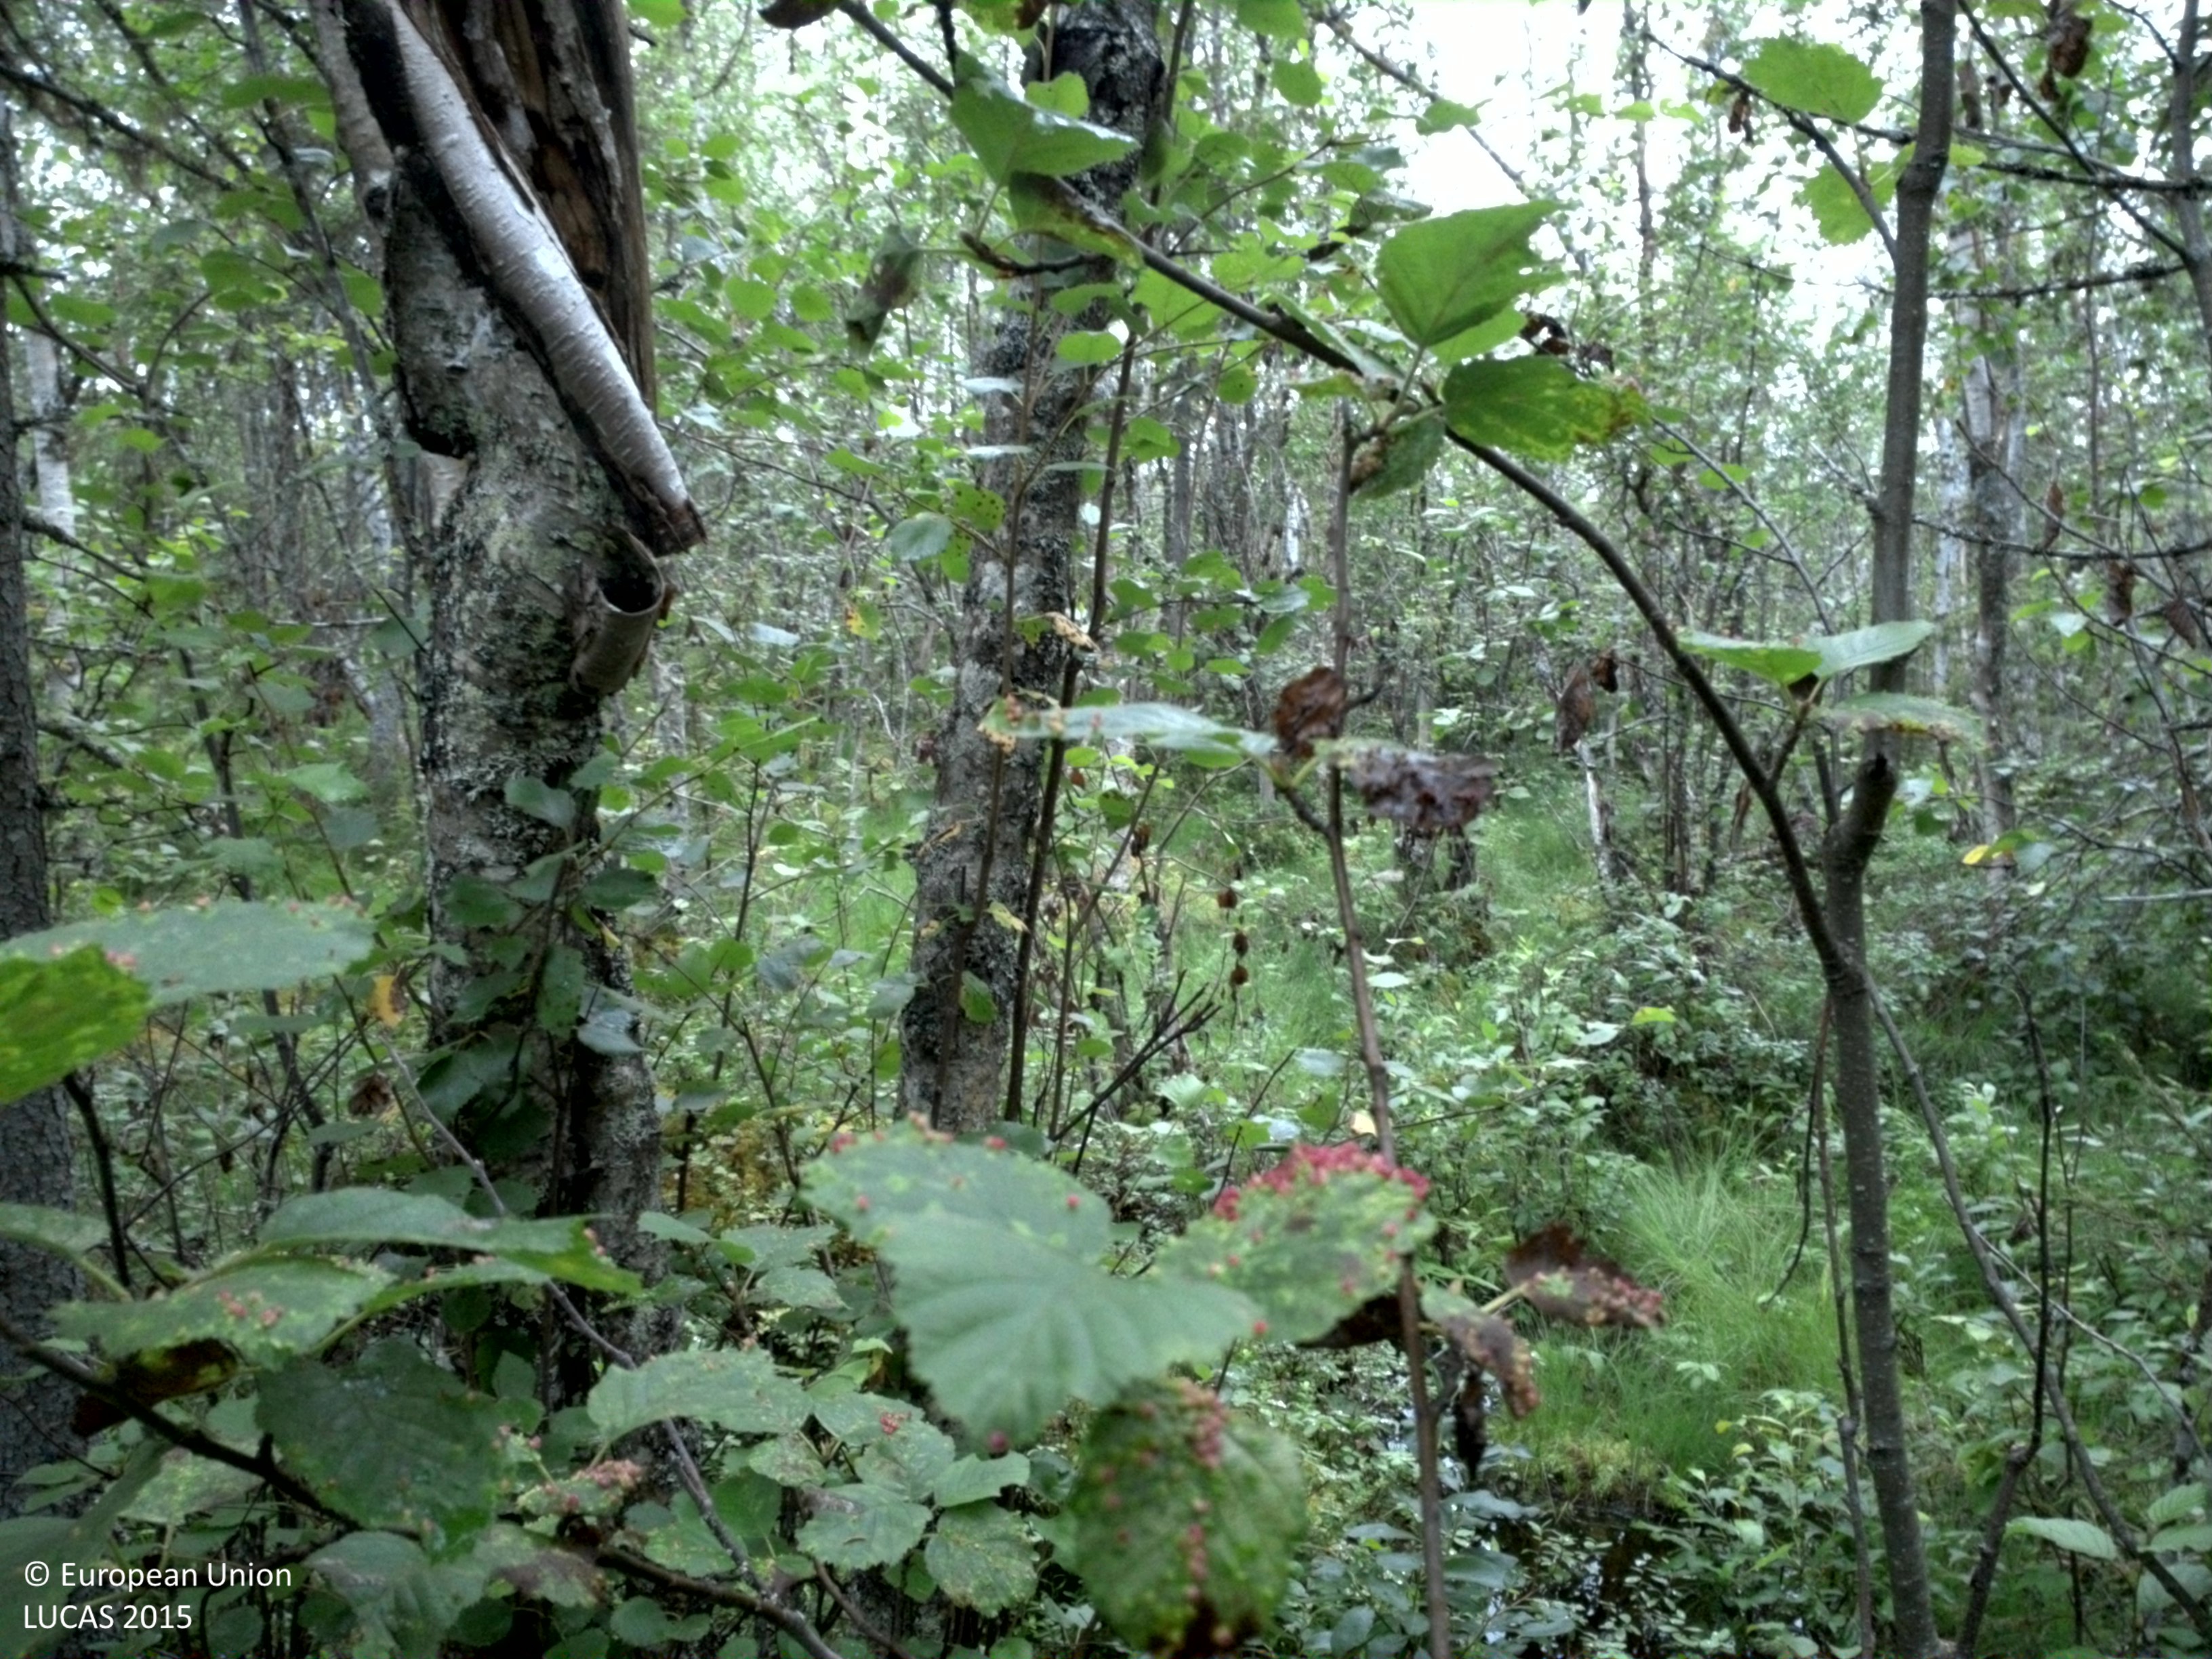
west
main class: Woodland
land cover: Broadleaved woodland
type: mire and swamp forests
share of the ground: 50 - 75 %
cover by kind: broadleaved forest trees 50 %, shrubs 30 %, coniferous forest trees 10 %
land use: Semi-natural and natural areas not in use
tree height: > 5 m
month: August
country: SE
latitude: 66.4948
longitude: 20.5395
